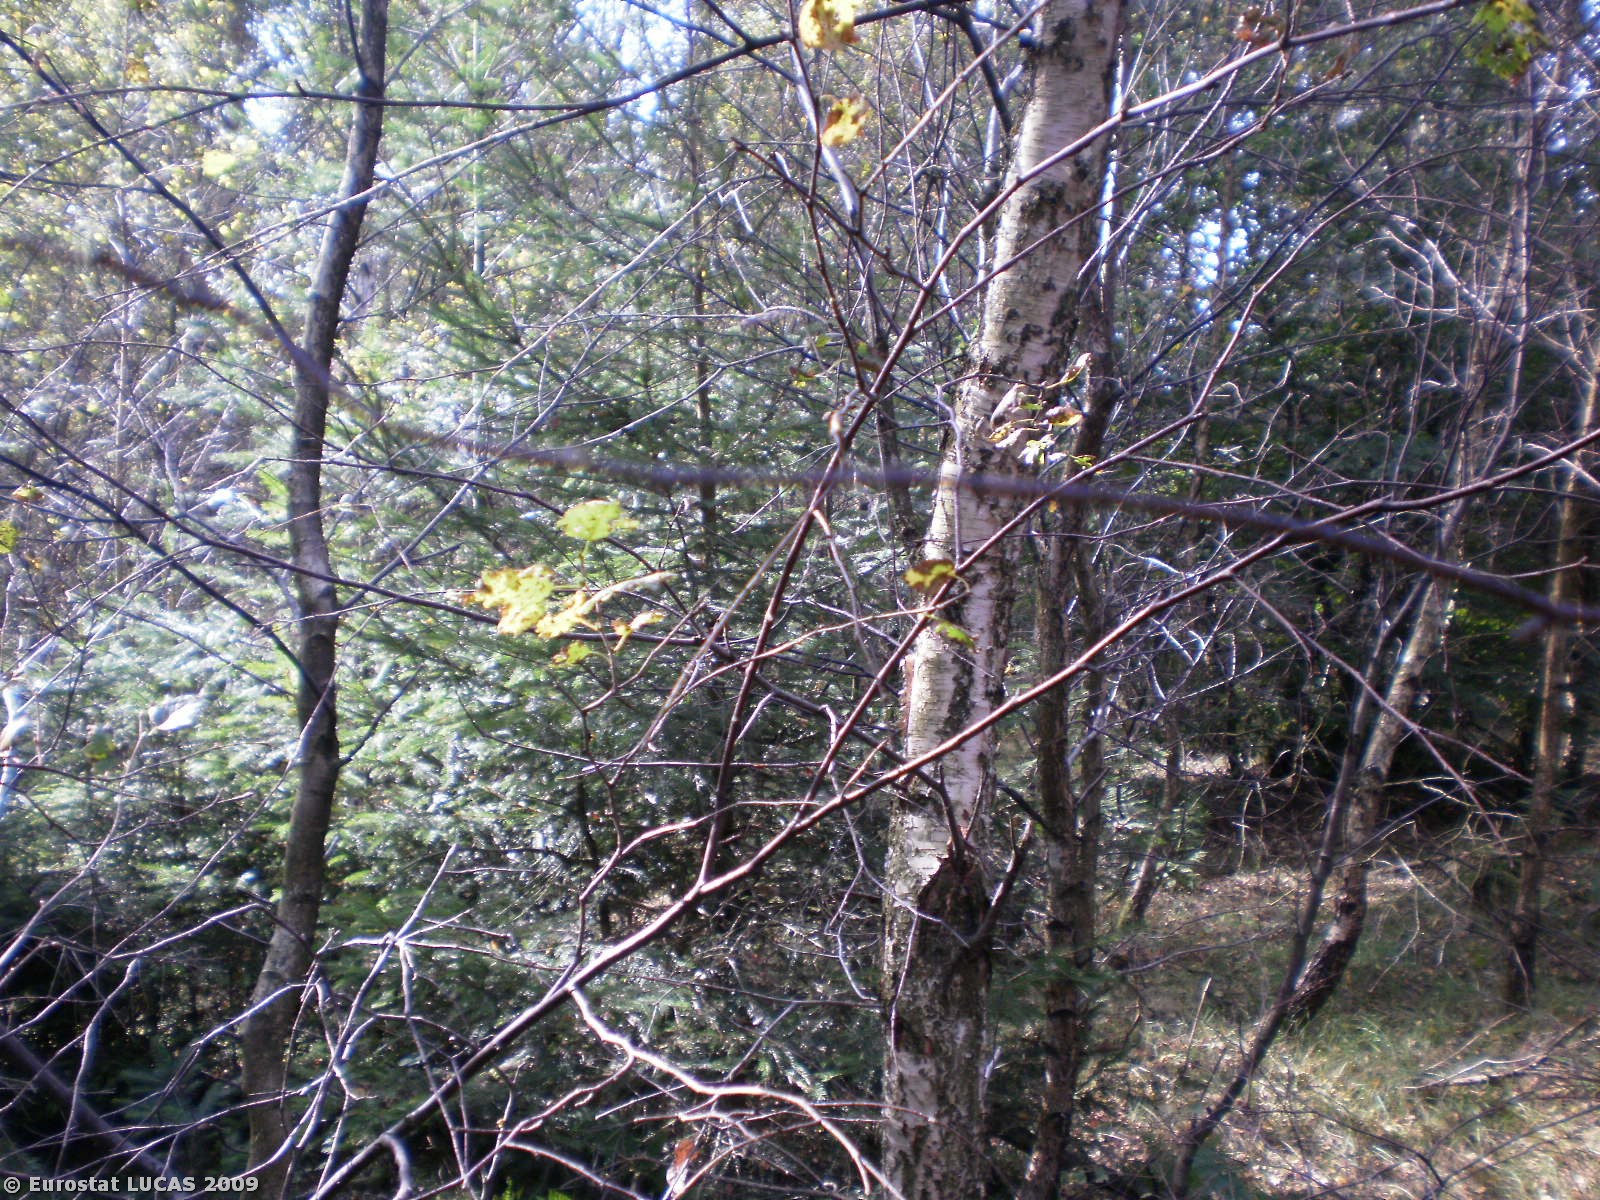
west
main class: Woodland
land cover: Mixed woodland
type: beech forest
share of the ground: > 75 %
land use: Forestry
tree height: > 5 m
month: September
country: BE
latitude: 50.3026
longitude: 6.2508
